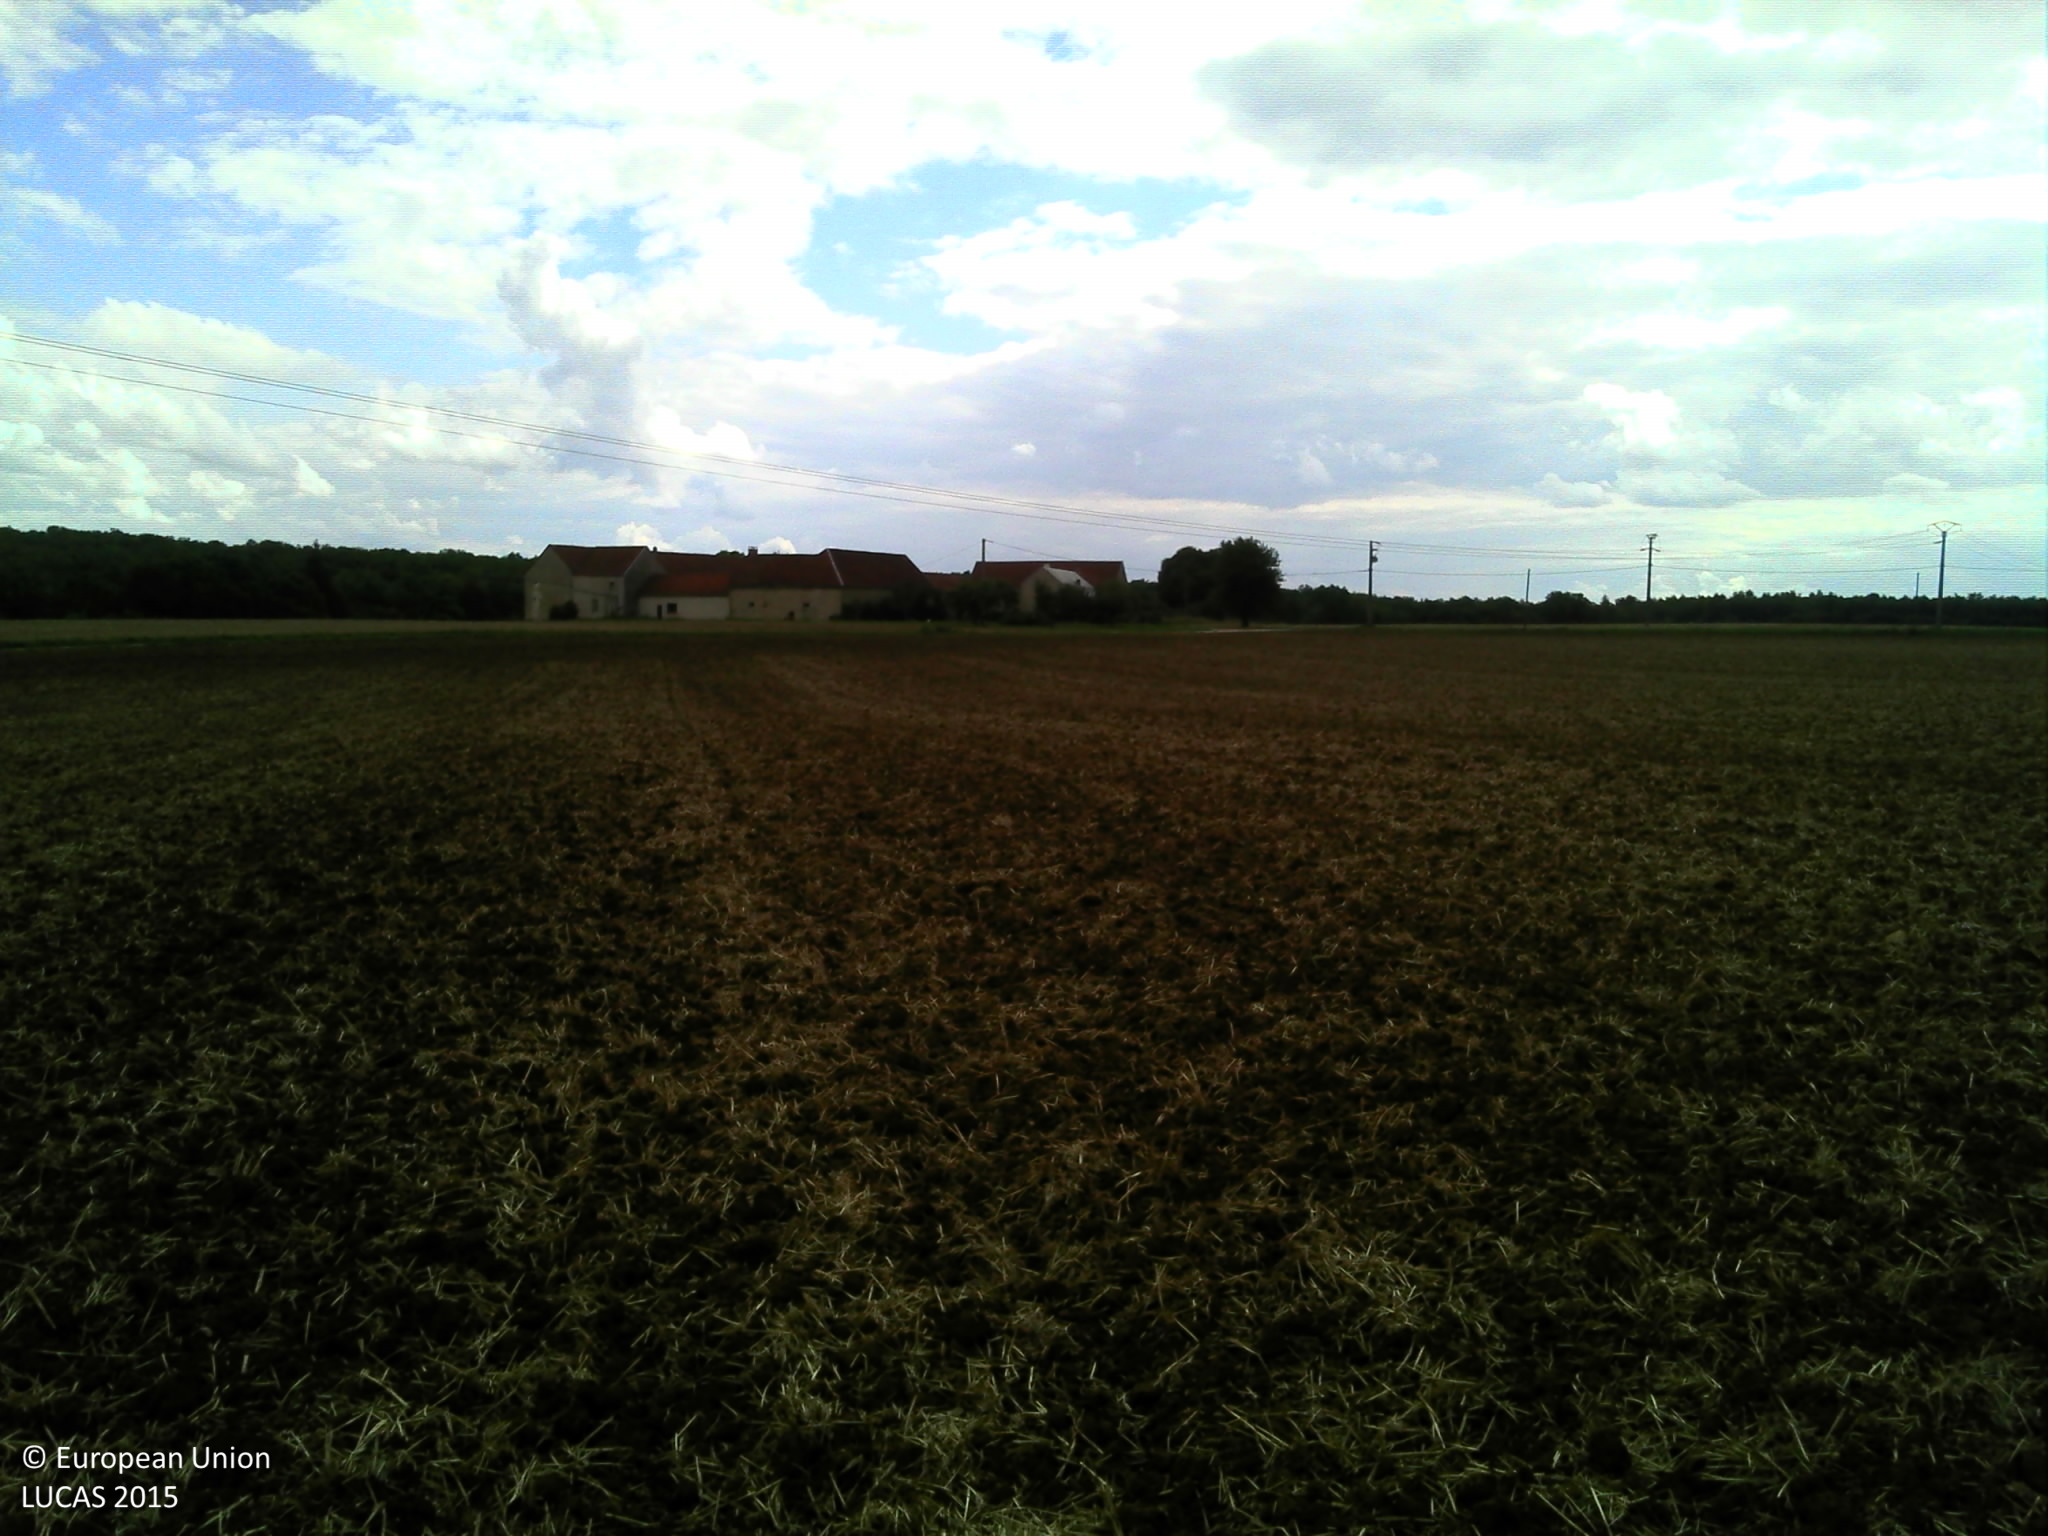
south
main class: Cropland
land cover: Common wheat
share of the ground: > 75 %
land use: Agriculture (excluding fallow land and kitchen gardens)
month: September
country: FR
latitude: 47.8081
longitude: 4.3496
